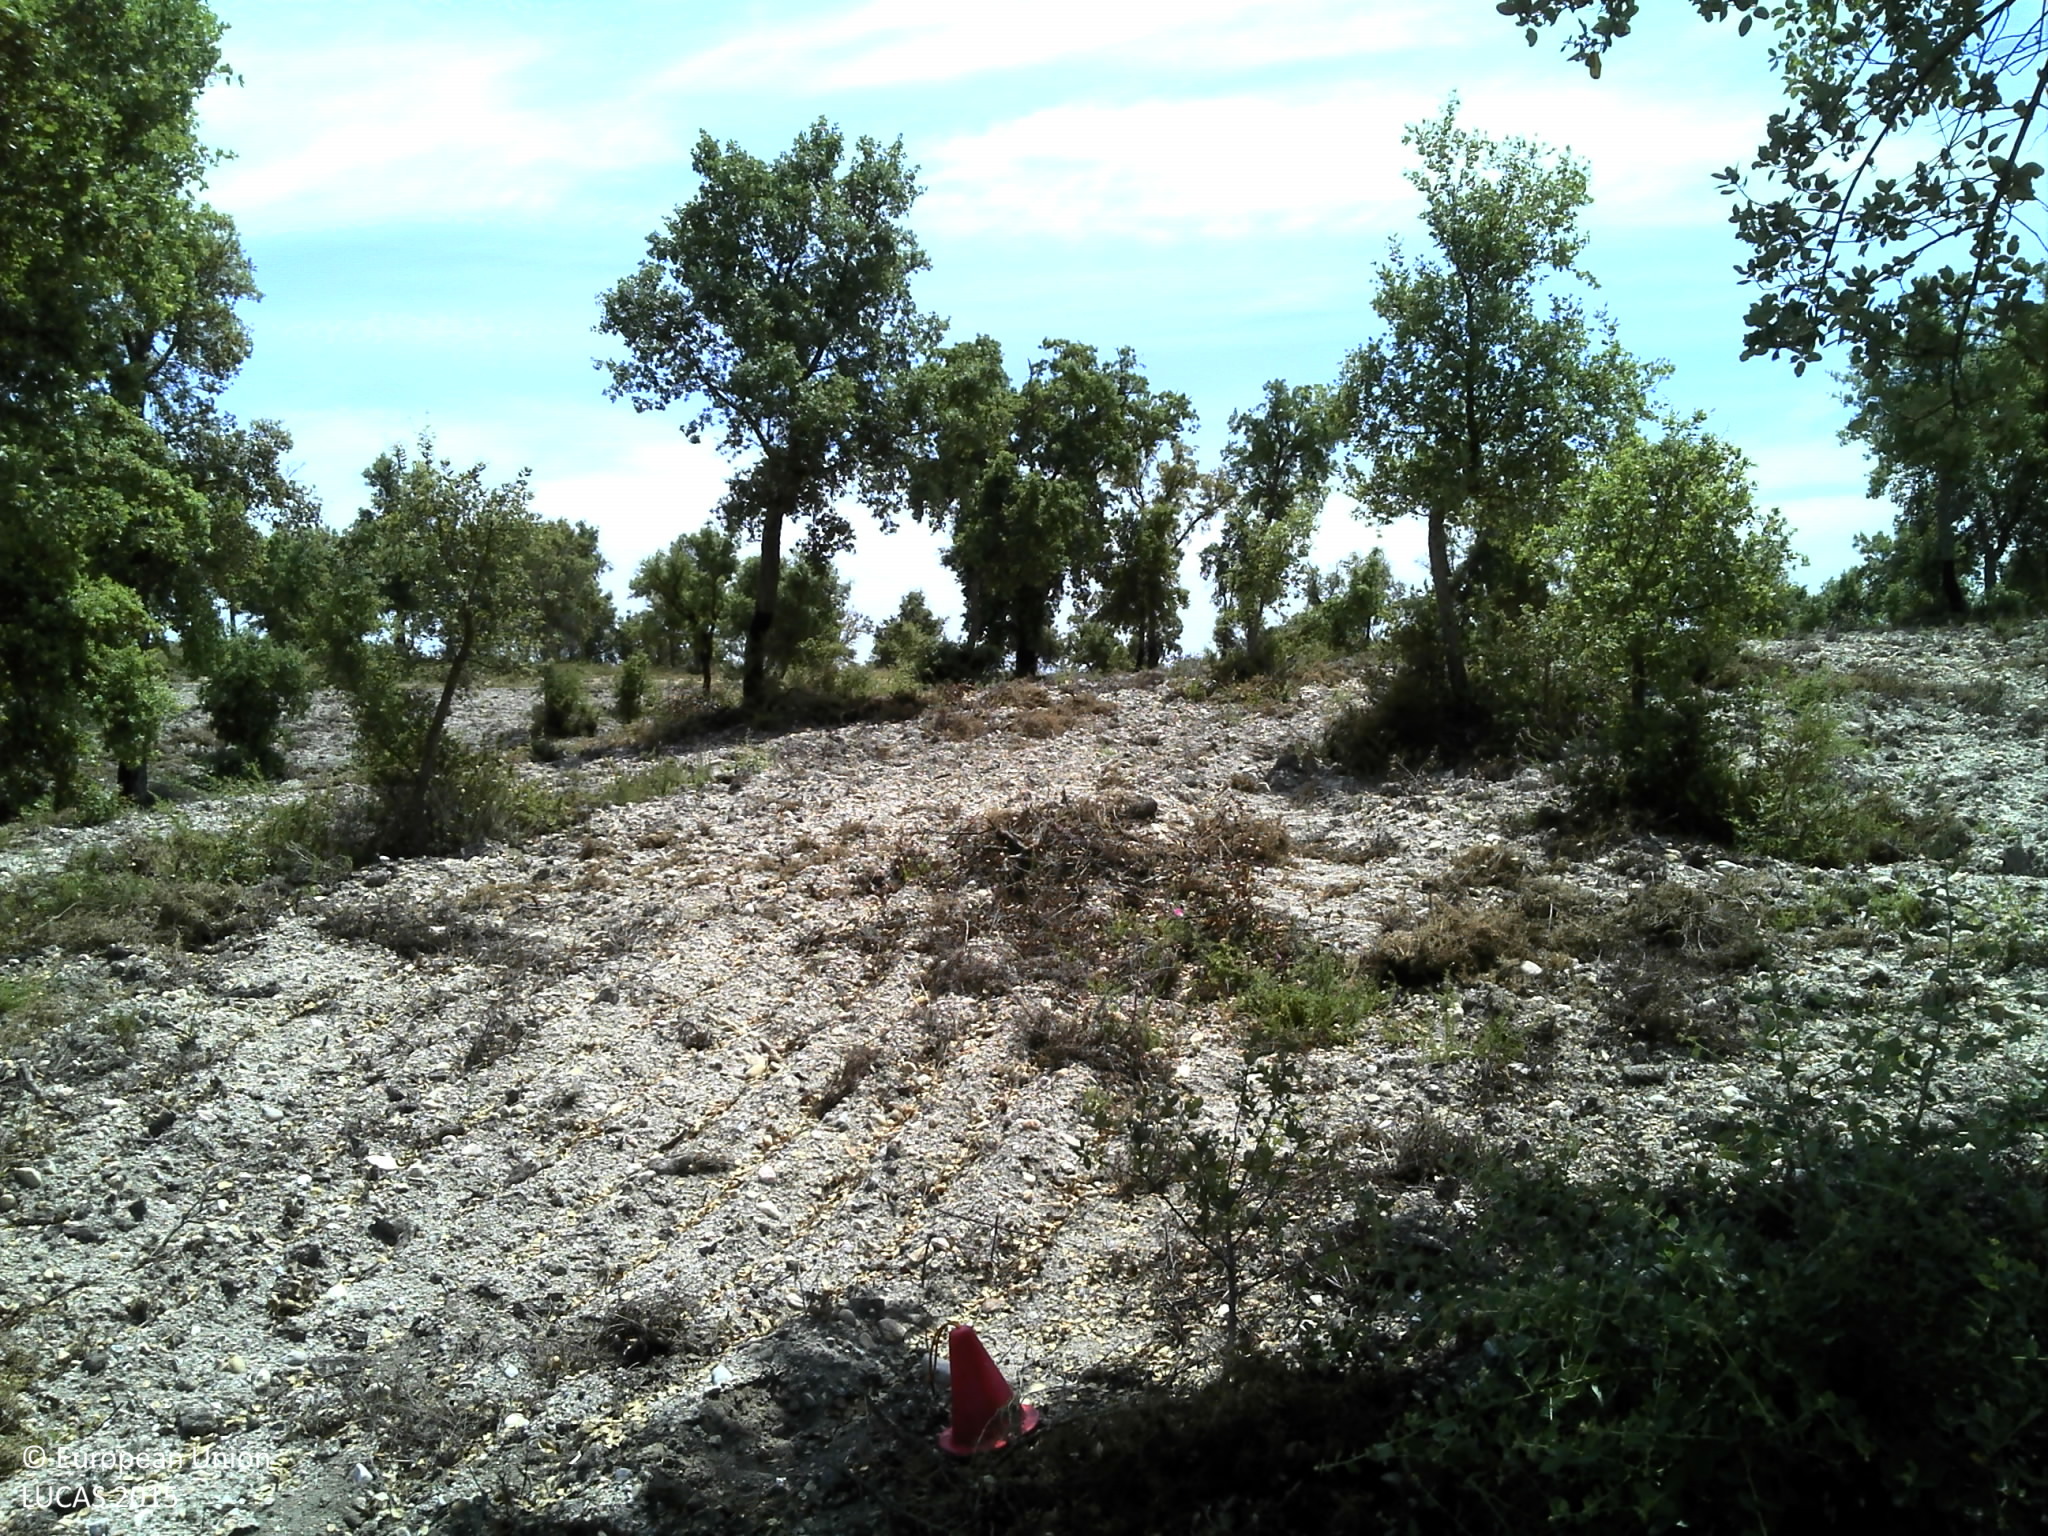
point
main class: Woodland
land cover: Broadleaved woodland
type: broadleaved evergreen forest
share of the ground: 25 - 50 %
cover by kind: unconsolidated bare surface 60 %, broadleaved forest trees 30 %, herbaceous plants 10 %
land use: Forestry
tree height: > 5 m
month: May
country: PT
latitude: 39.2728
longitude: -7.8913
